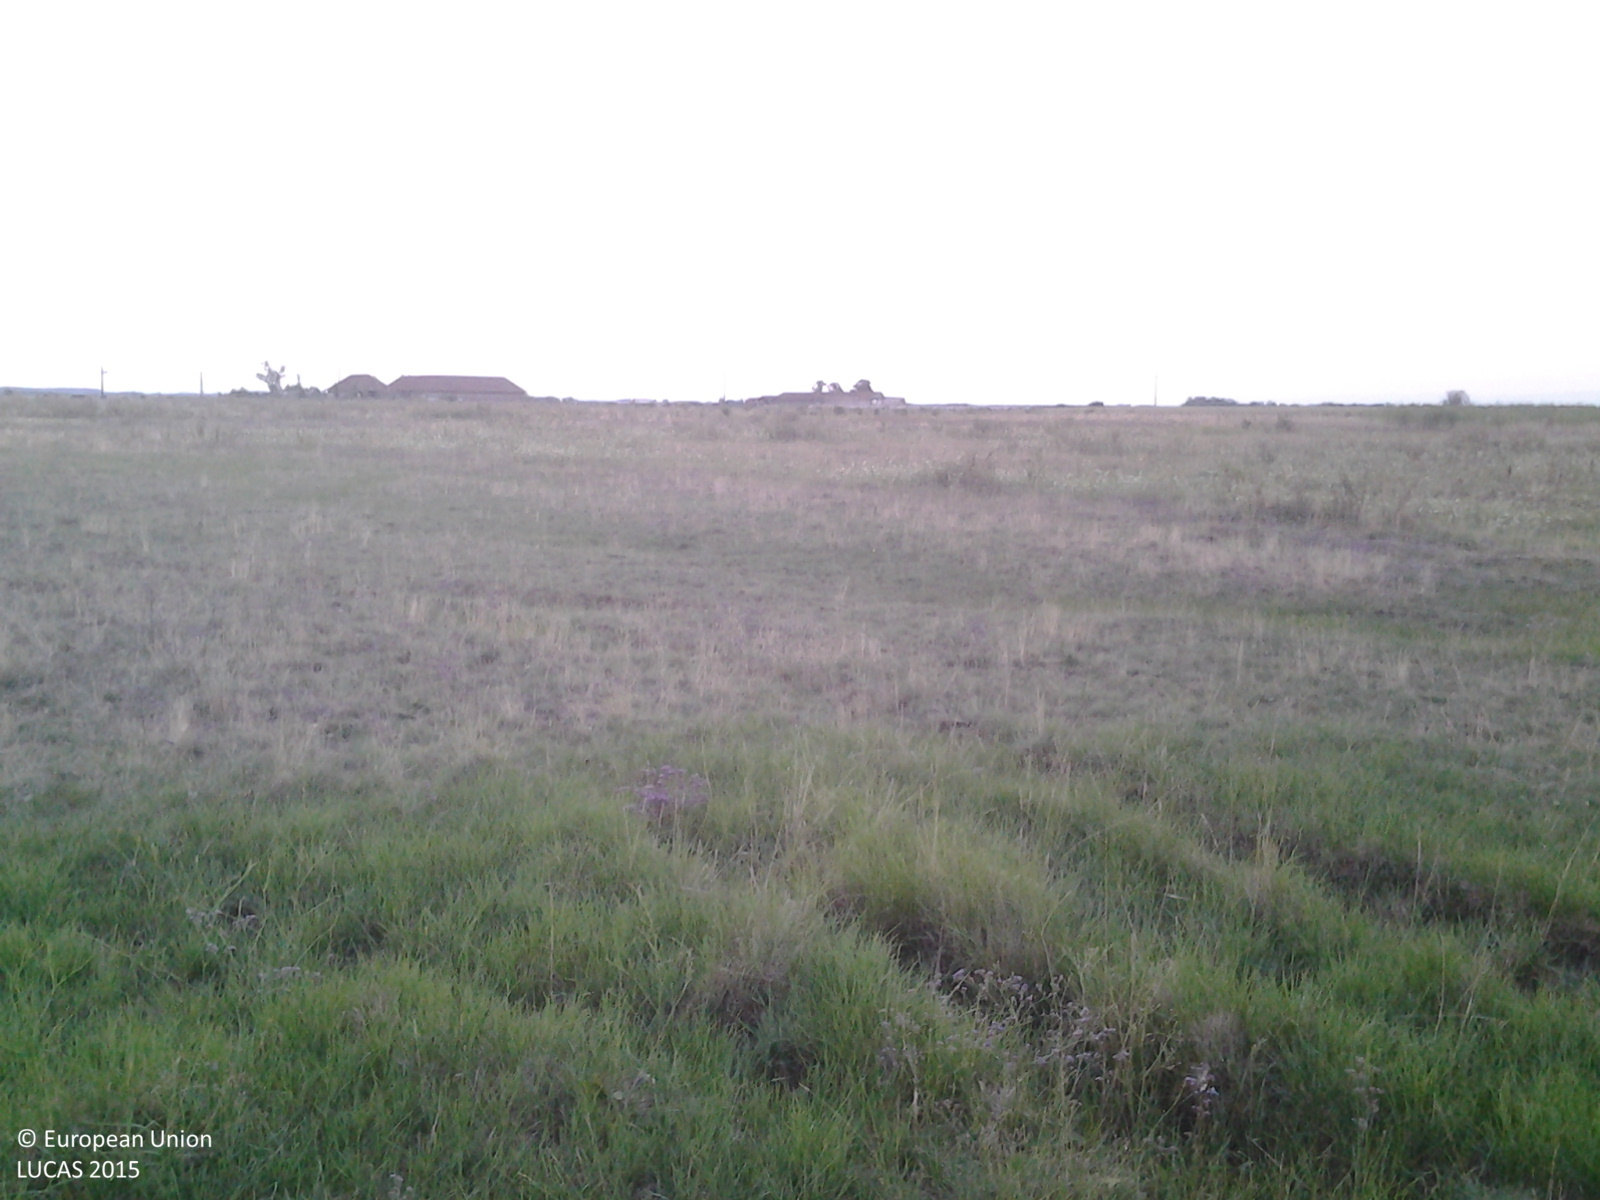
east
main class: Grassland
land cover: Grassland without tree/shrub cover
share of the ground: > 75 %
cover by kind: herbaceous plants 100 %
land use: Agriculture (excluding fallow land and kitchen gardens)
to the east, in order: Grassland without tree/shrub cover
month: August
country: HU
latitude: 46.8571
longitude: 21.4900
